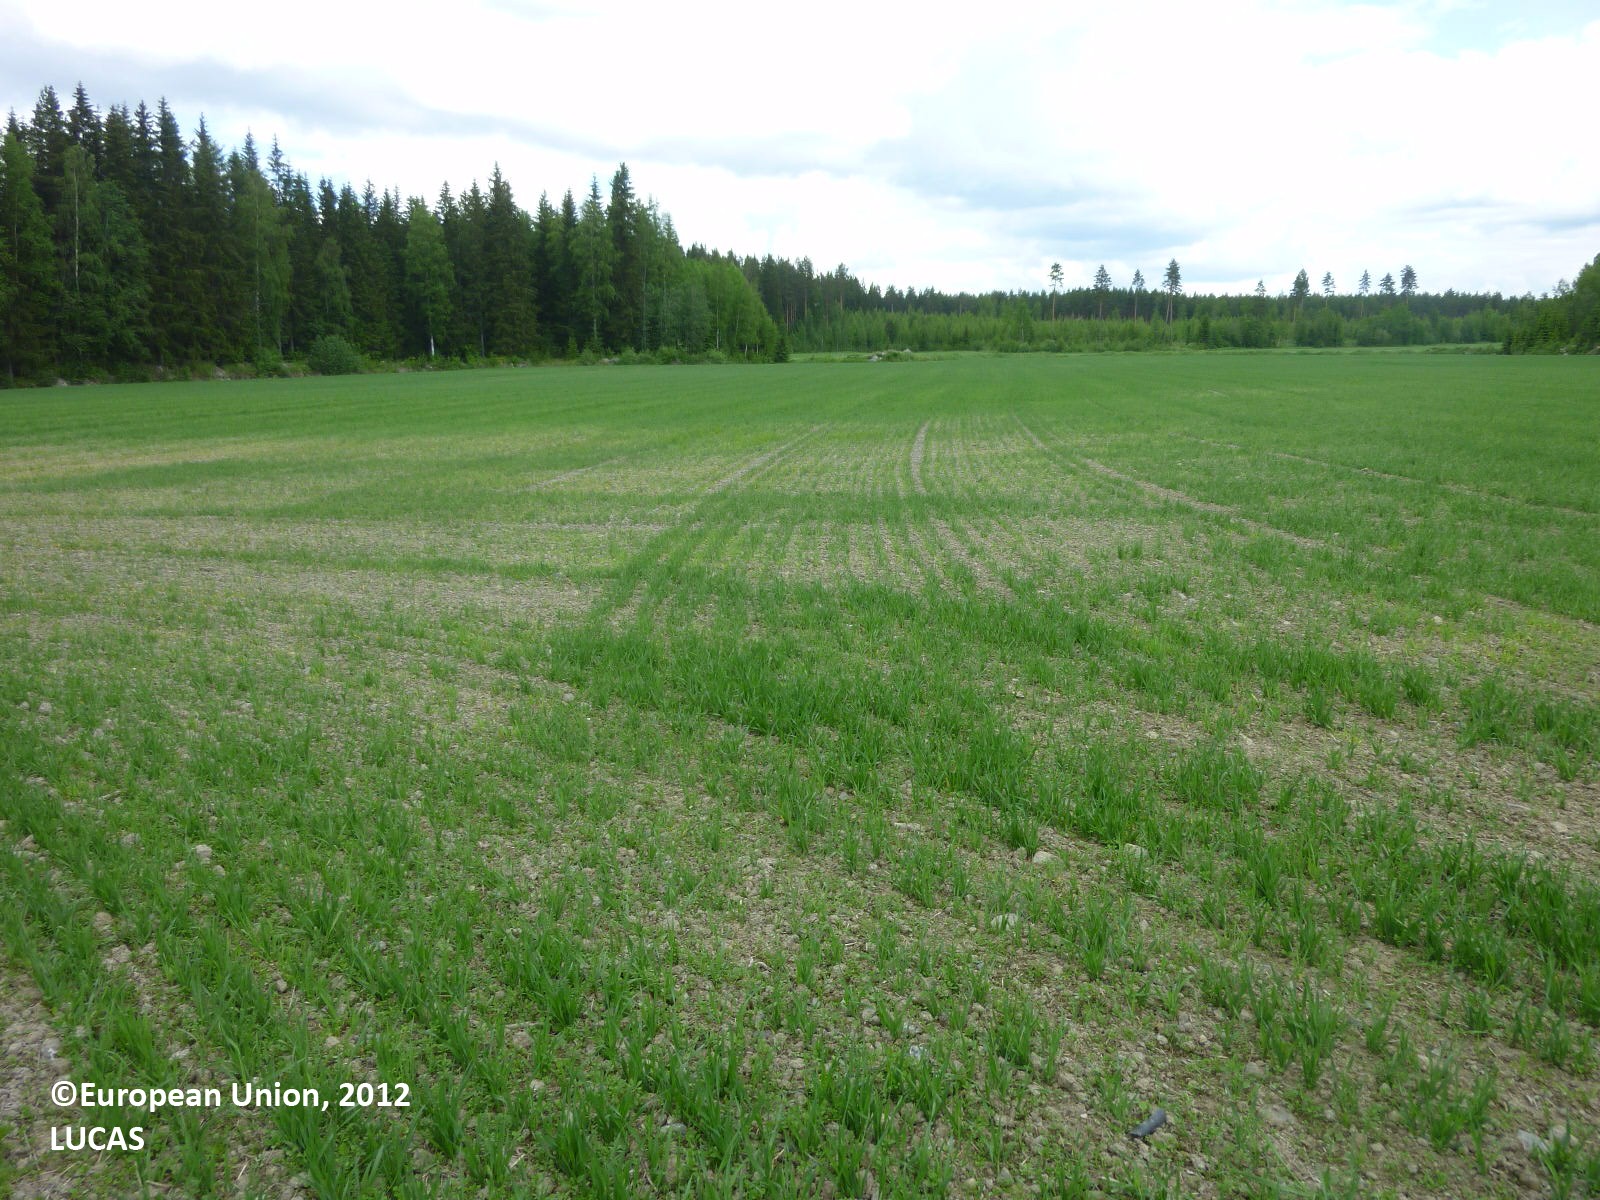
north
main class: Cropland
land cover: Barley
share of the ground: 50 - 75 %
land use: Agriculture (excluding fallow land and kitchen gardens)
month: June
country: FI
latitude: 61.4073
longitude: 22.5586
